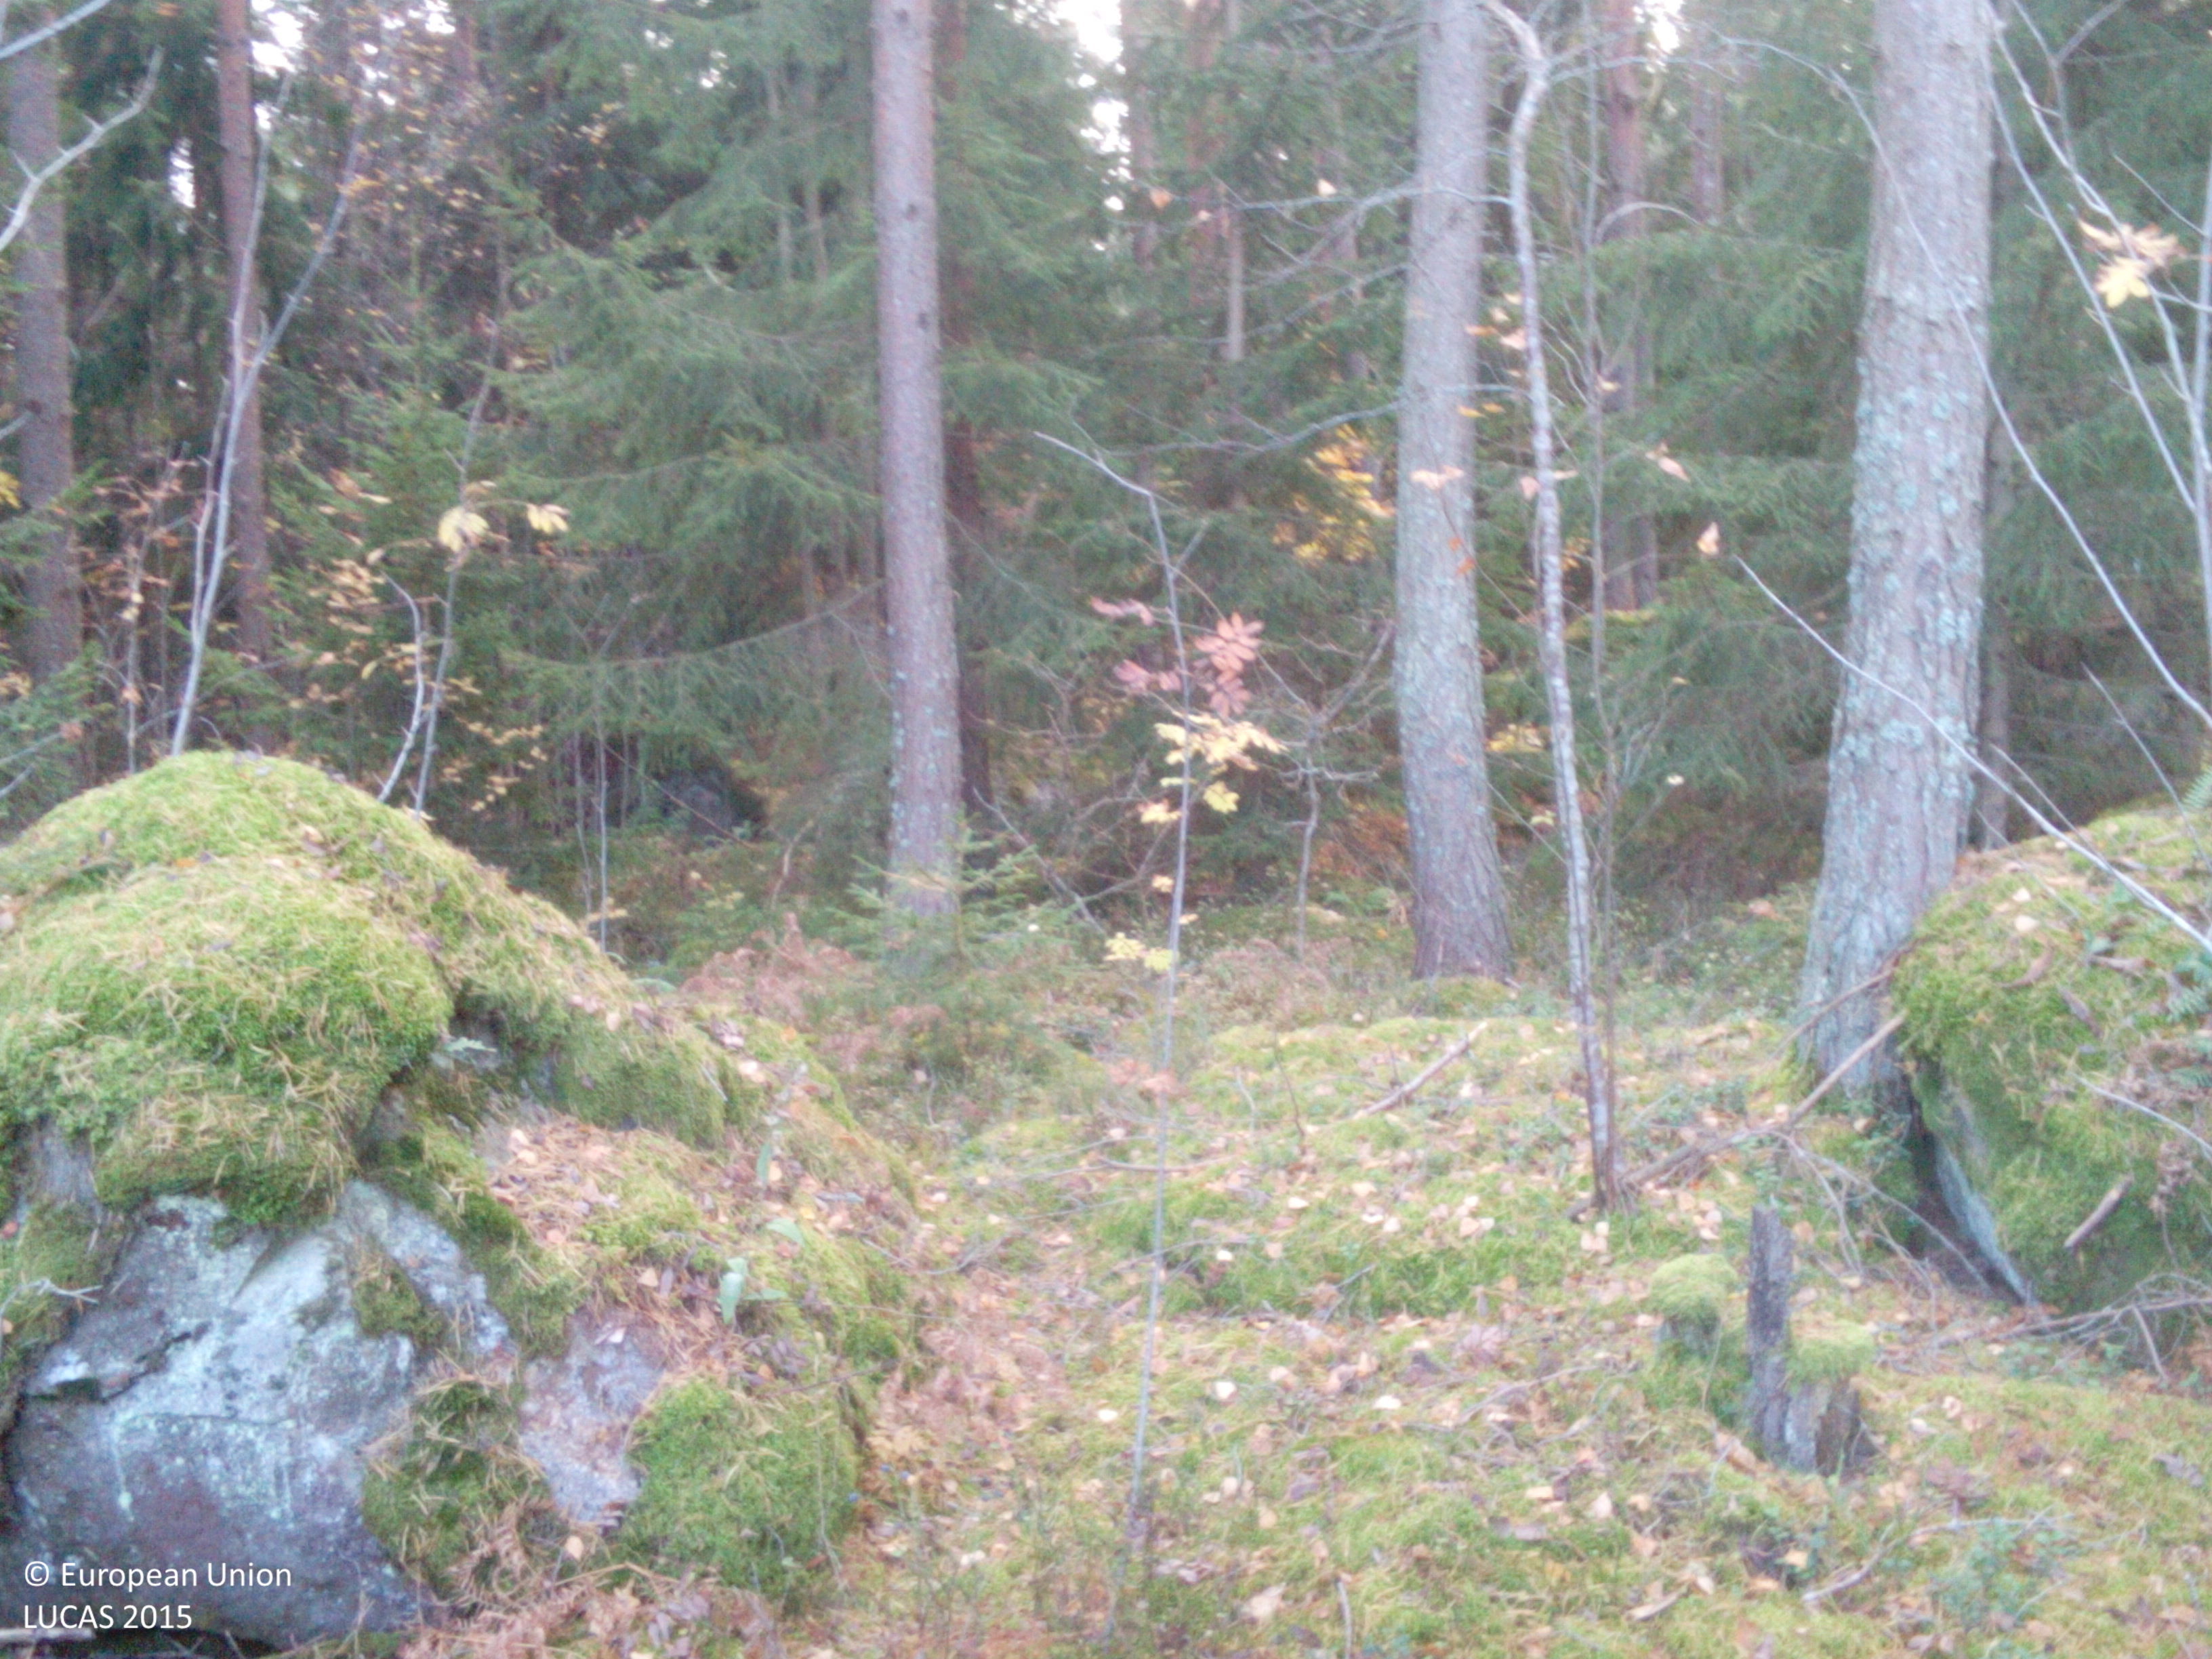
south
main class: Woodland
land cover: Other coniferous woodland
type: boreal forest
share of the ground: > 75 %
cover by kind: coniferous forest trees 85 %, lichens and mosses 10 %, herbaceous plants 5 %
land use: Forestry
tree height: > 5 m
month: October
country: SE
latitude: 59.0325
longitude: 16.2139
